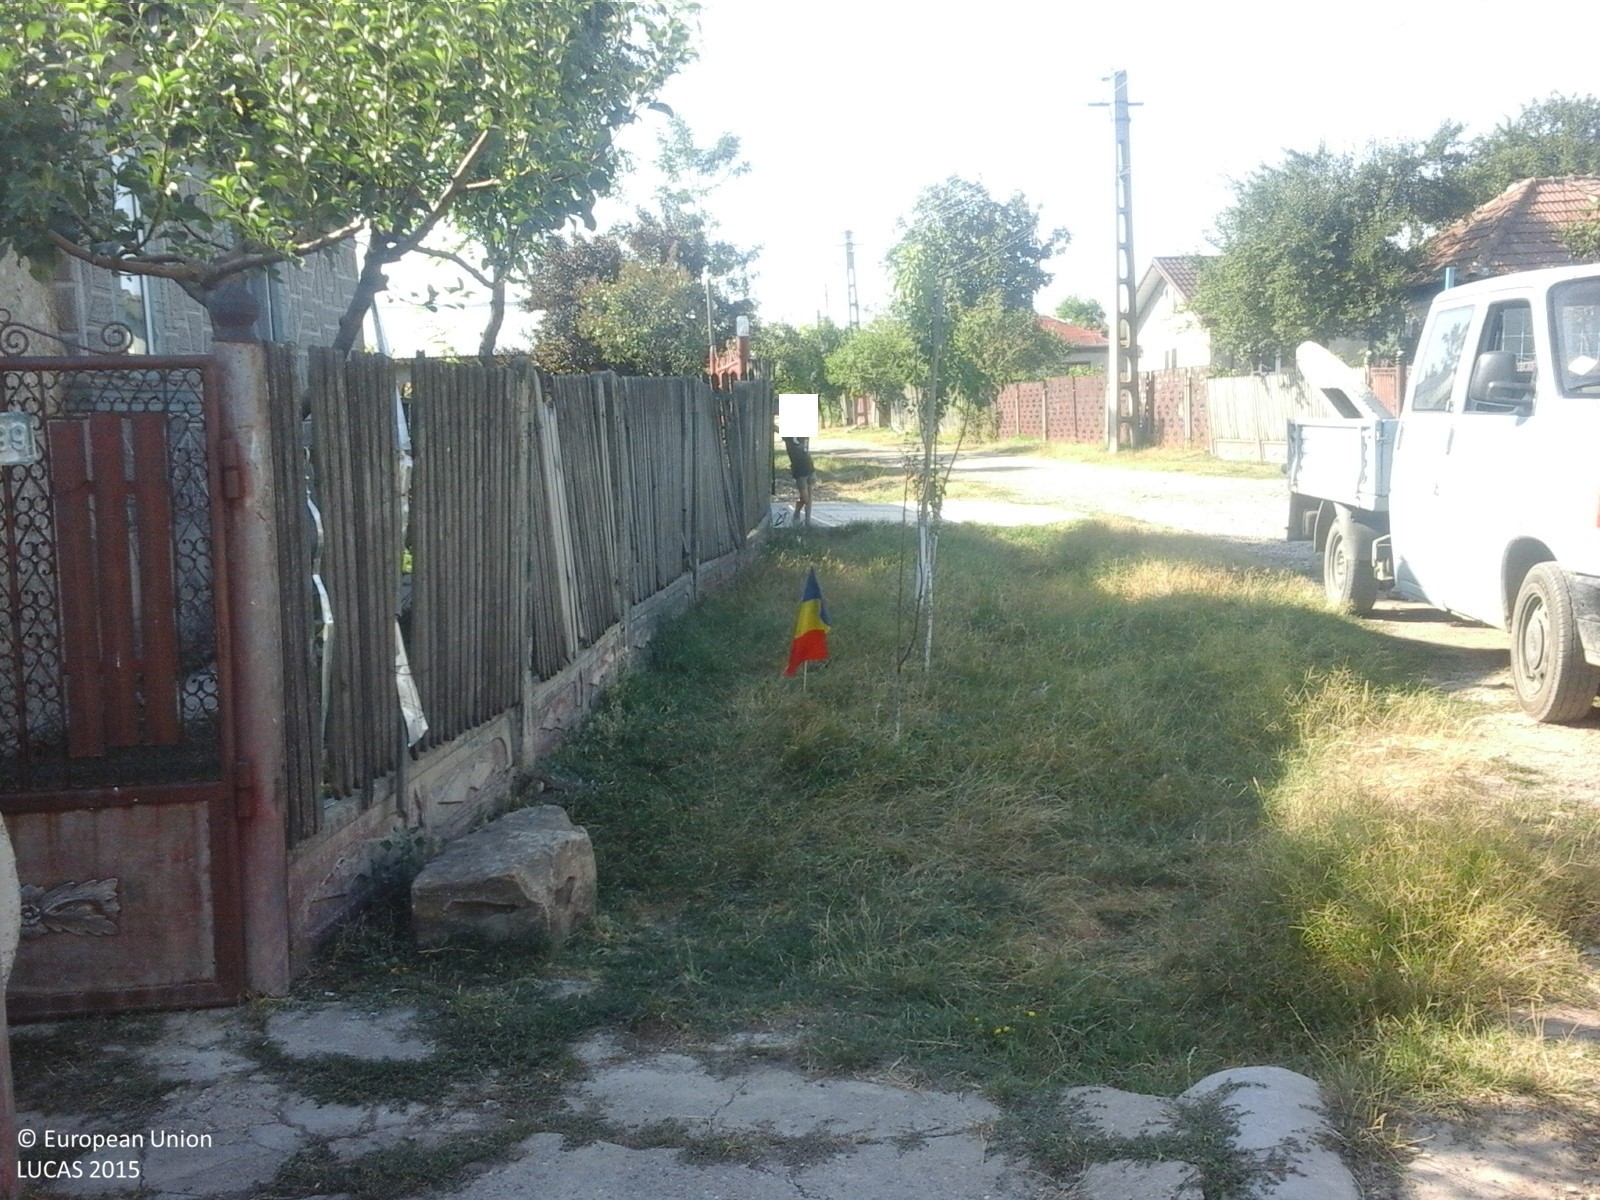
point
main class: Grassland
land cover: Grassland with sparse tree/shrub cover
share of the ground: > 75 %
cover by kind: herbaceous plants 90 %, broadleaved forest trees 5 %, shrubs 5 %
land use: Agriculture (excluding fallow land and kitchen gardens)
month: August
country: RO
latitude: 45.0807
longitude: 26.7053
